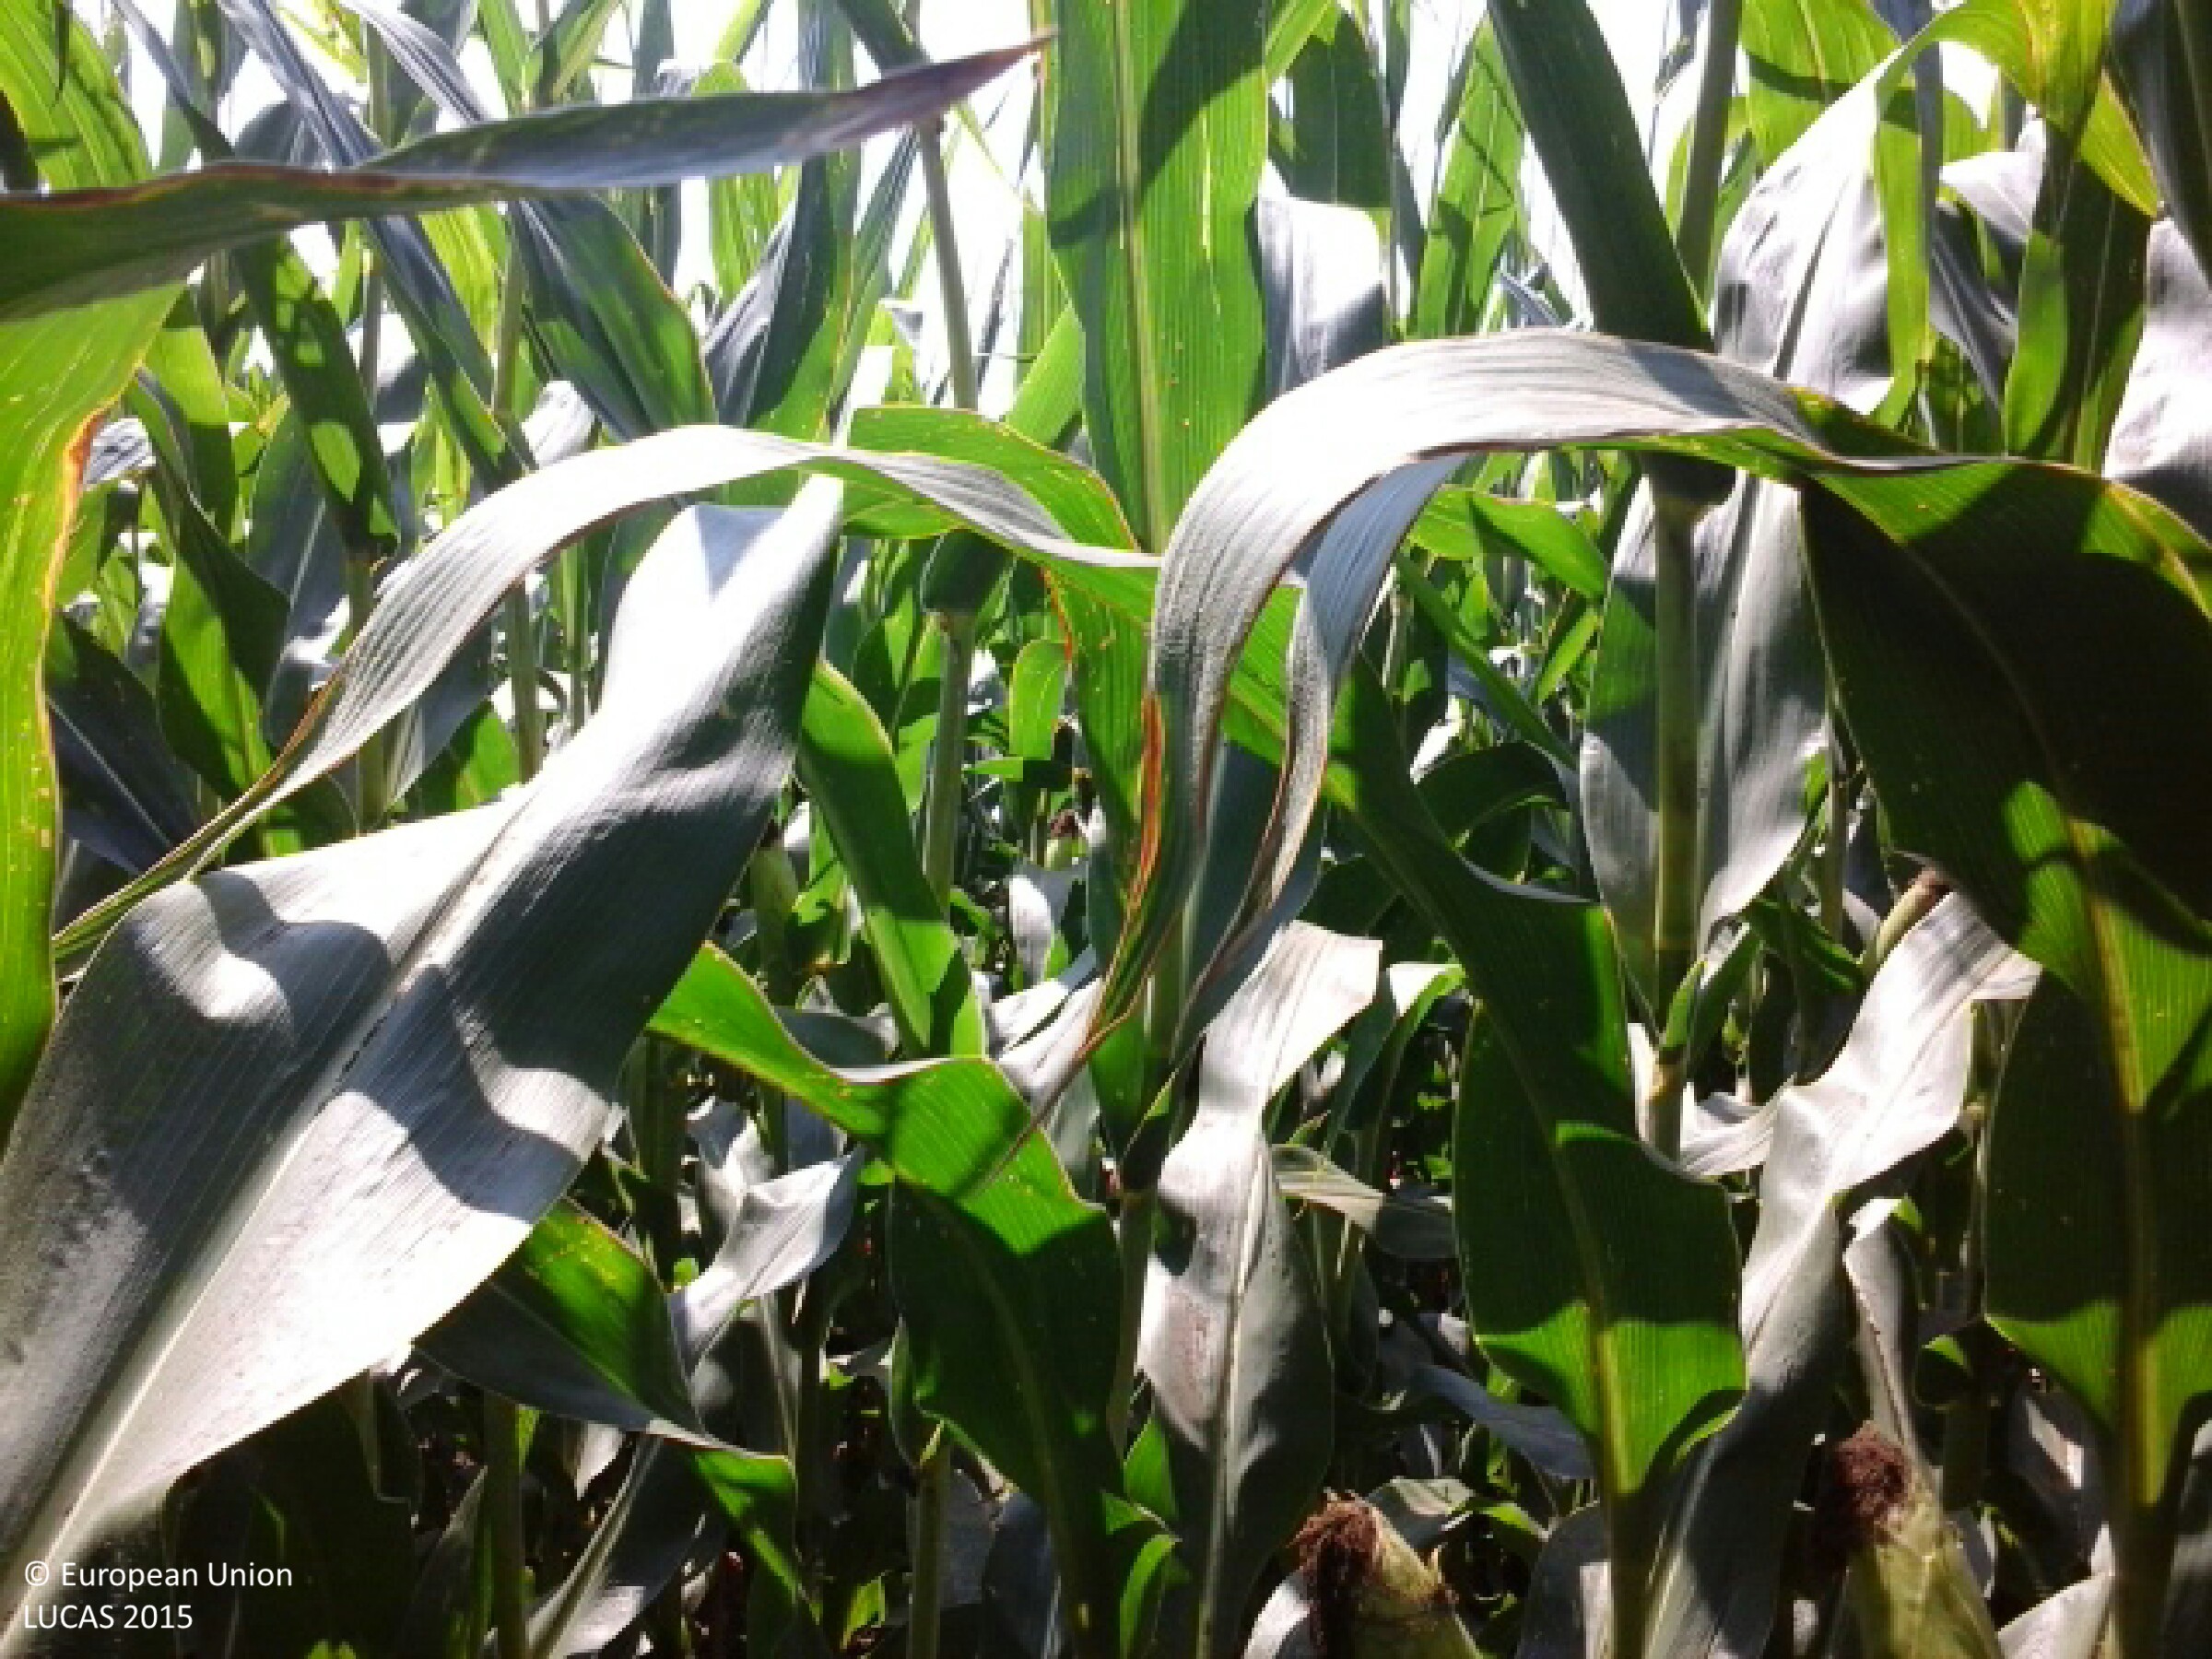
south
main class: Cropland
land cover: Maize
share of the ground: > 75 %
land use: Agriculture (excluding fallow land and kitchen gardens)
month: August
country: HU
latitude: 47.6325
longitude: 18.1436
